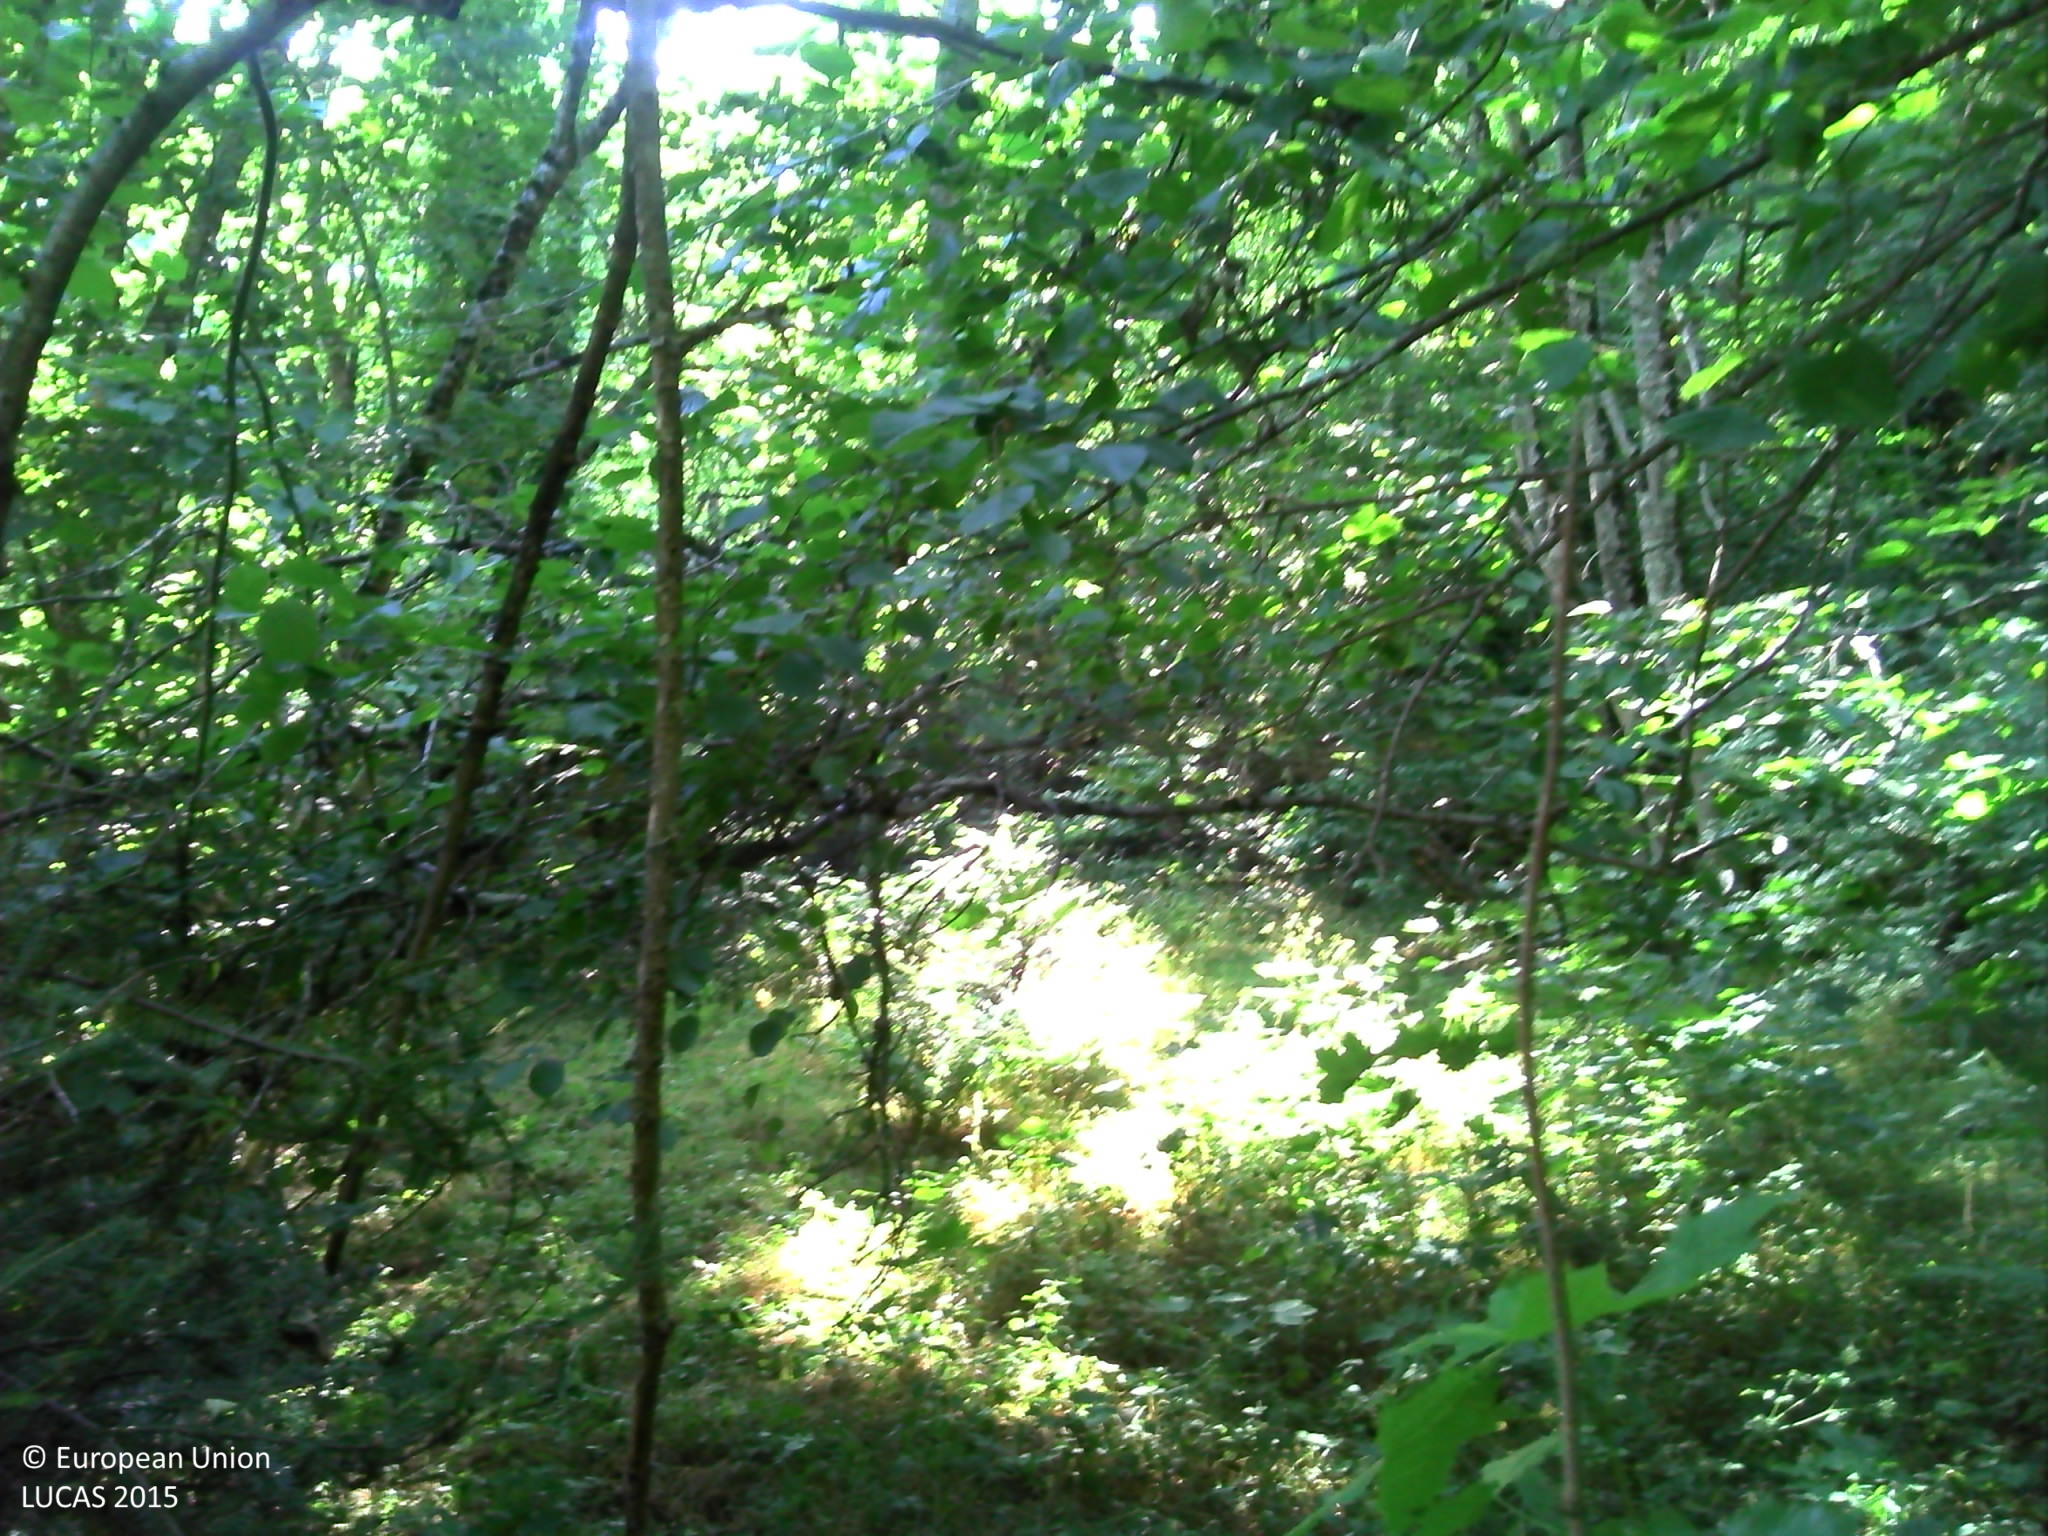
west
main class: Woodland
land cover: Broadleaved woodland
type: mesophytic deciduous forest
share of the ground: > 75 %
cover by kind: broadleaved forest trees 80 %, shrubs 10 %, herbaceous plants 10 %
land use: Forestry
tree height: > 5 m
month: July
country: FR
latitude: 45.2204
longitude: 4.2353
